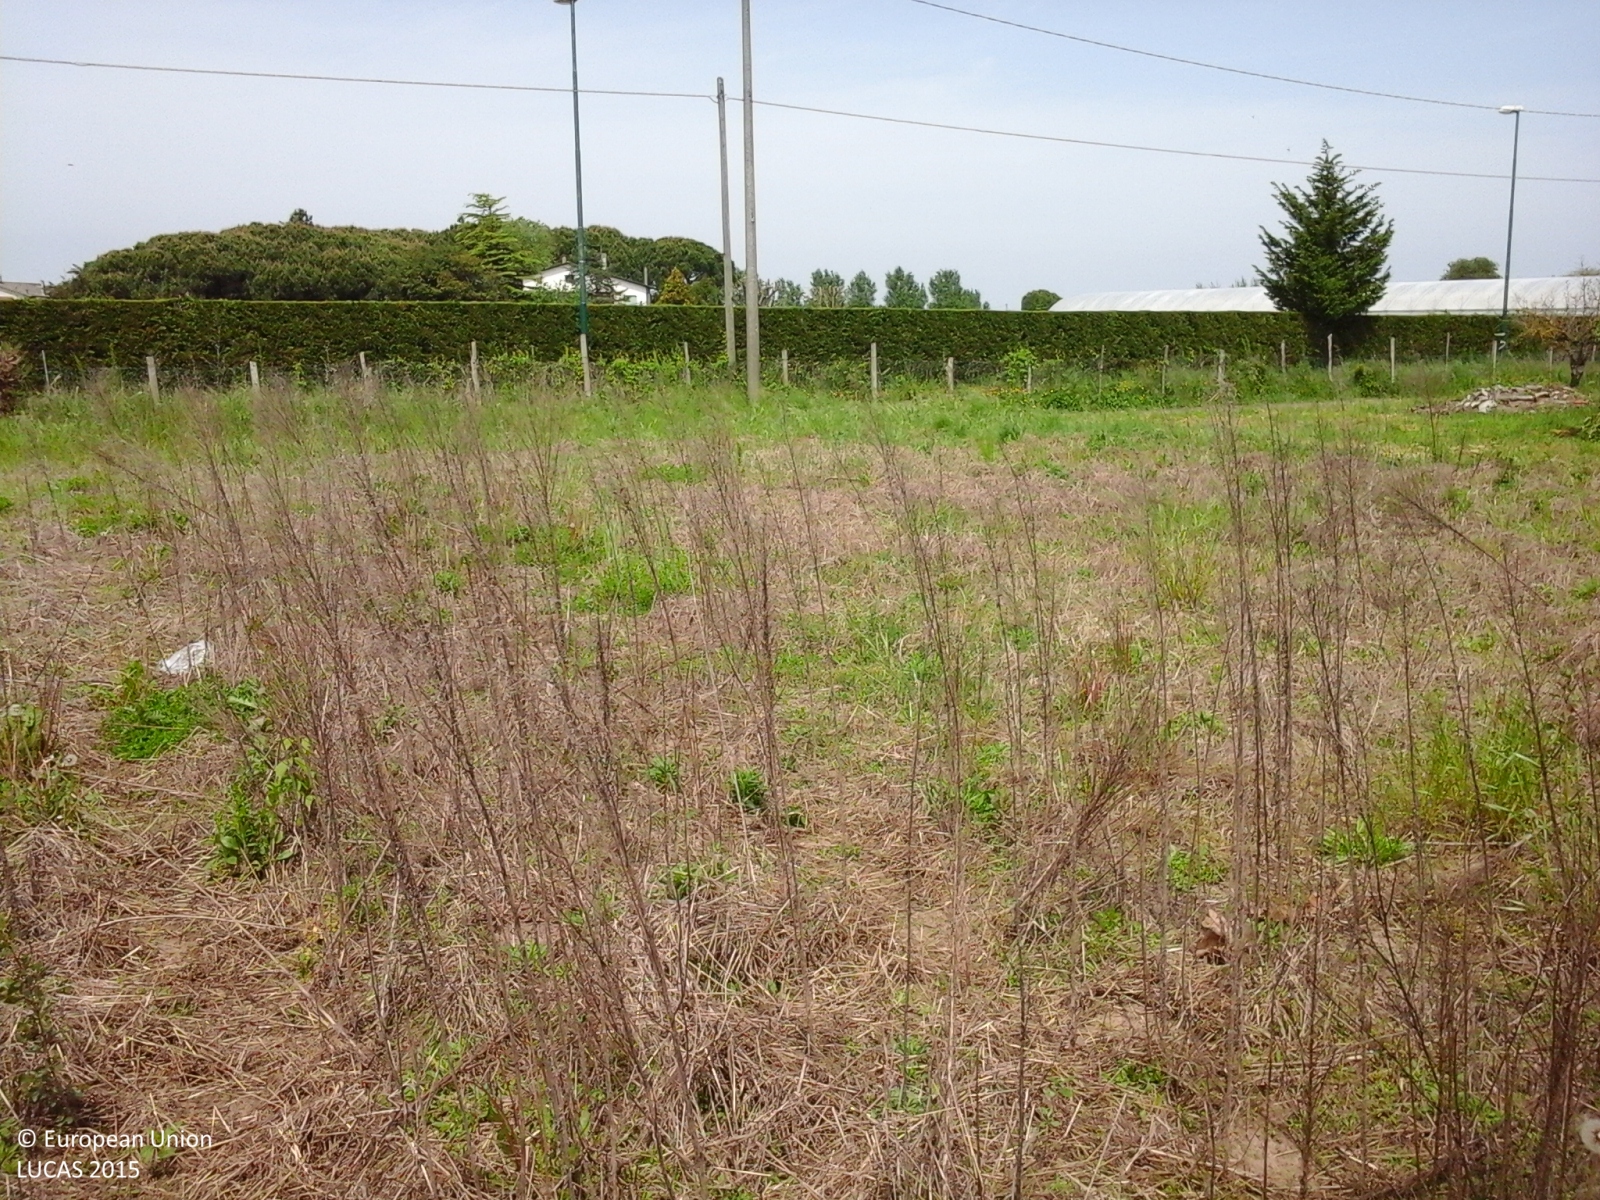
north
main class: Grassland
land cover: Spontaneously vegetated surfaces
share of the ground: 50 - 75 %
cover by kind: herbaceous plants 75 %, consolidated bare surface 25 %
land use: Fallow land
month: May
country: IT
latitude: 45.4402
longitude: 12.4380
